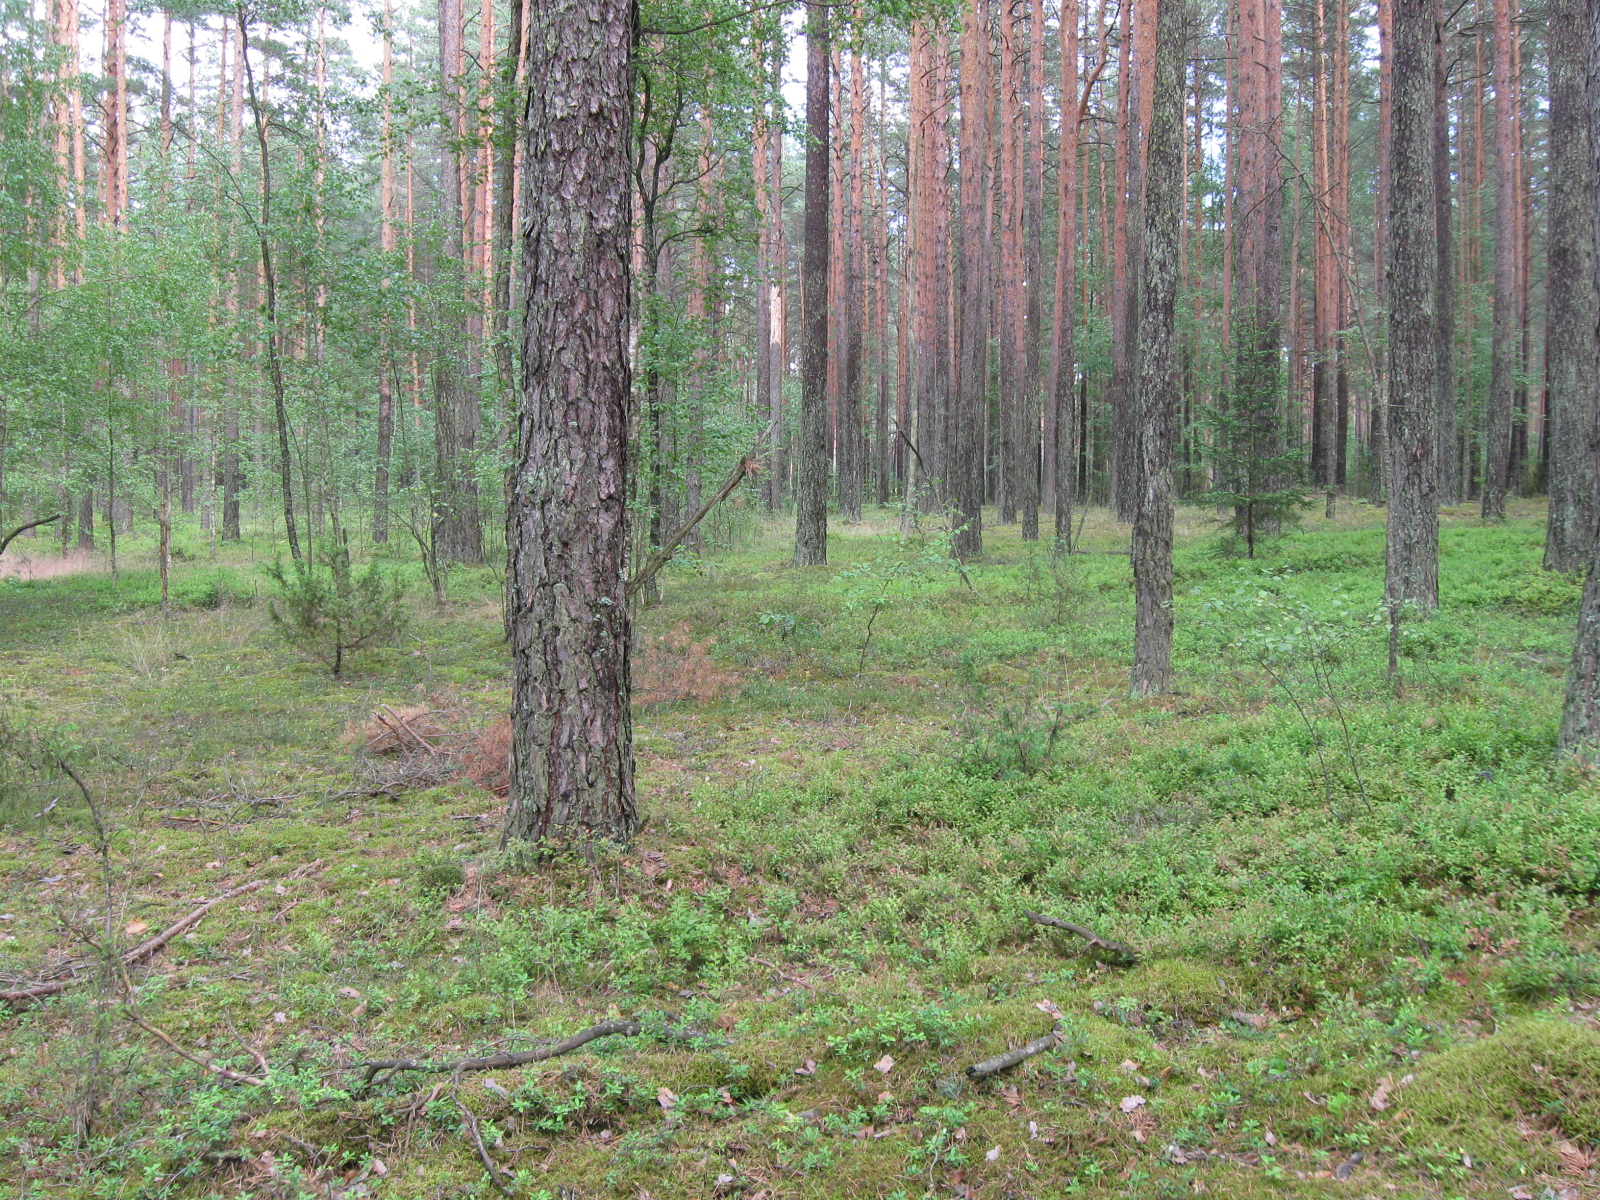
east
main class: Woodland
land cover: Pine dominated coniferous woodland
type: hemiboreal forest and nemoral coniferous forest and mixed broadleaved-coniferous forest
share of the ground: 50 - 75 %
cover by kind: coniferous forest trees 65 %, shrubs 15 %, lichens and mosses 10 %, broadleaved forest trees 5 %, herbaceous plants 5 %
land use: Forestry
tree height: > 5 m
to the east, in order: Pine dominated coniferous woodland
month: July
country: LT
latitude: 53.9716
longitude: 23.5143
